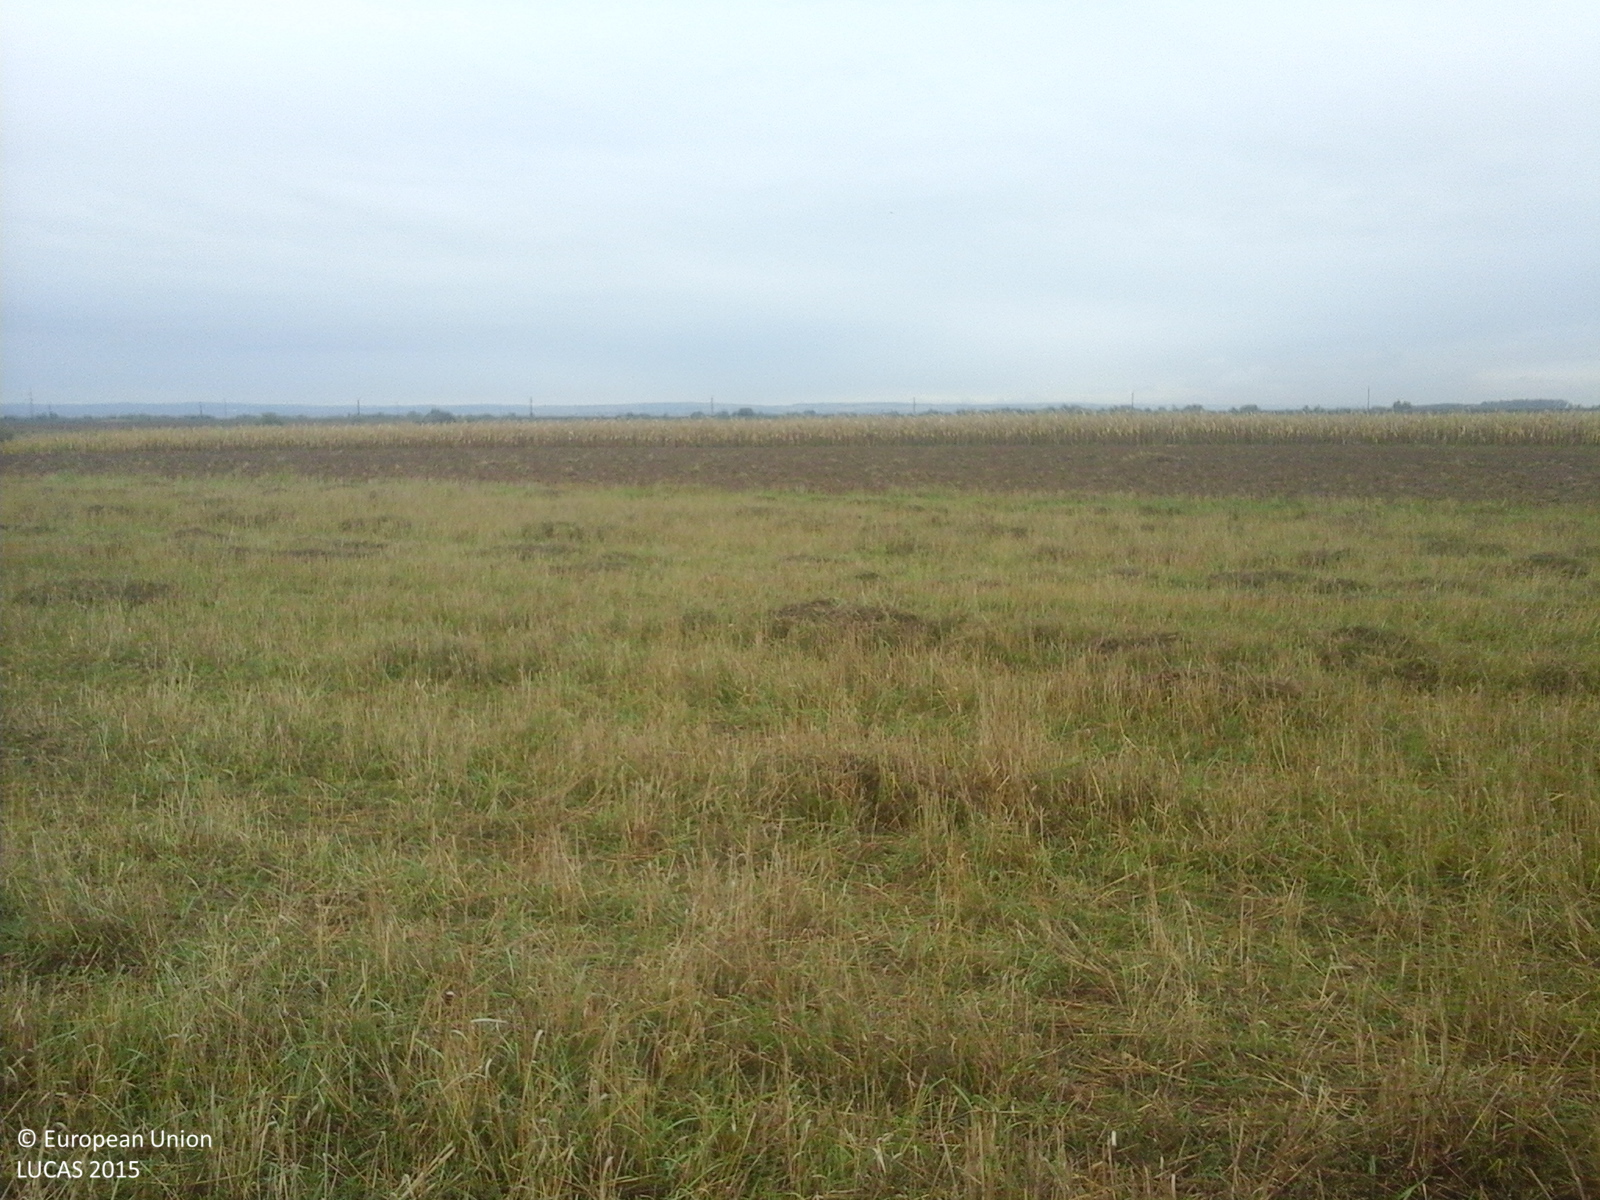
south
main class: Cropland
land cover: Common wheat
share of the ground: 10 - 25 %
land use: Agriculture (excluding fallow land and kitchen gardens)
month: September
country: RO
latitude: 47.2433
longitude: 21.9508
